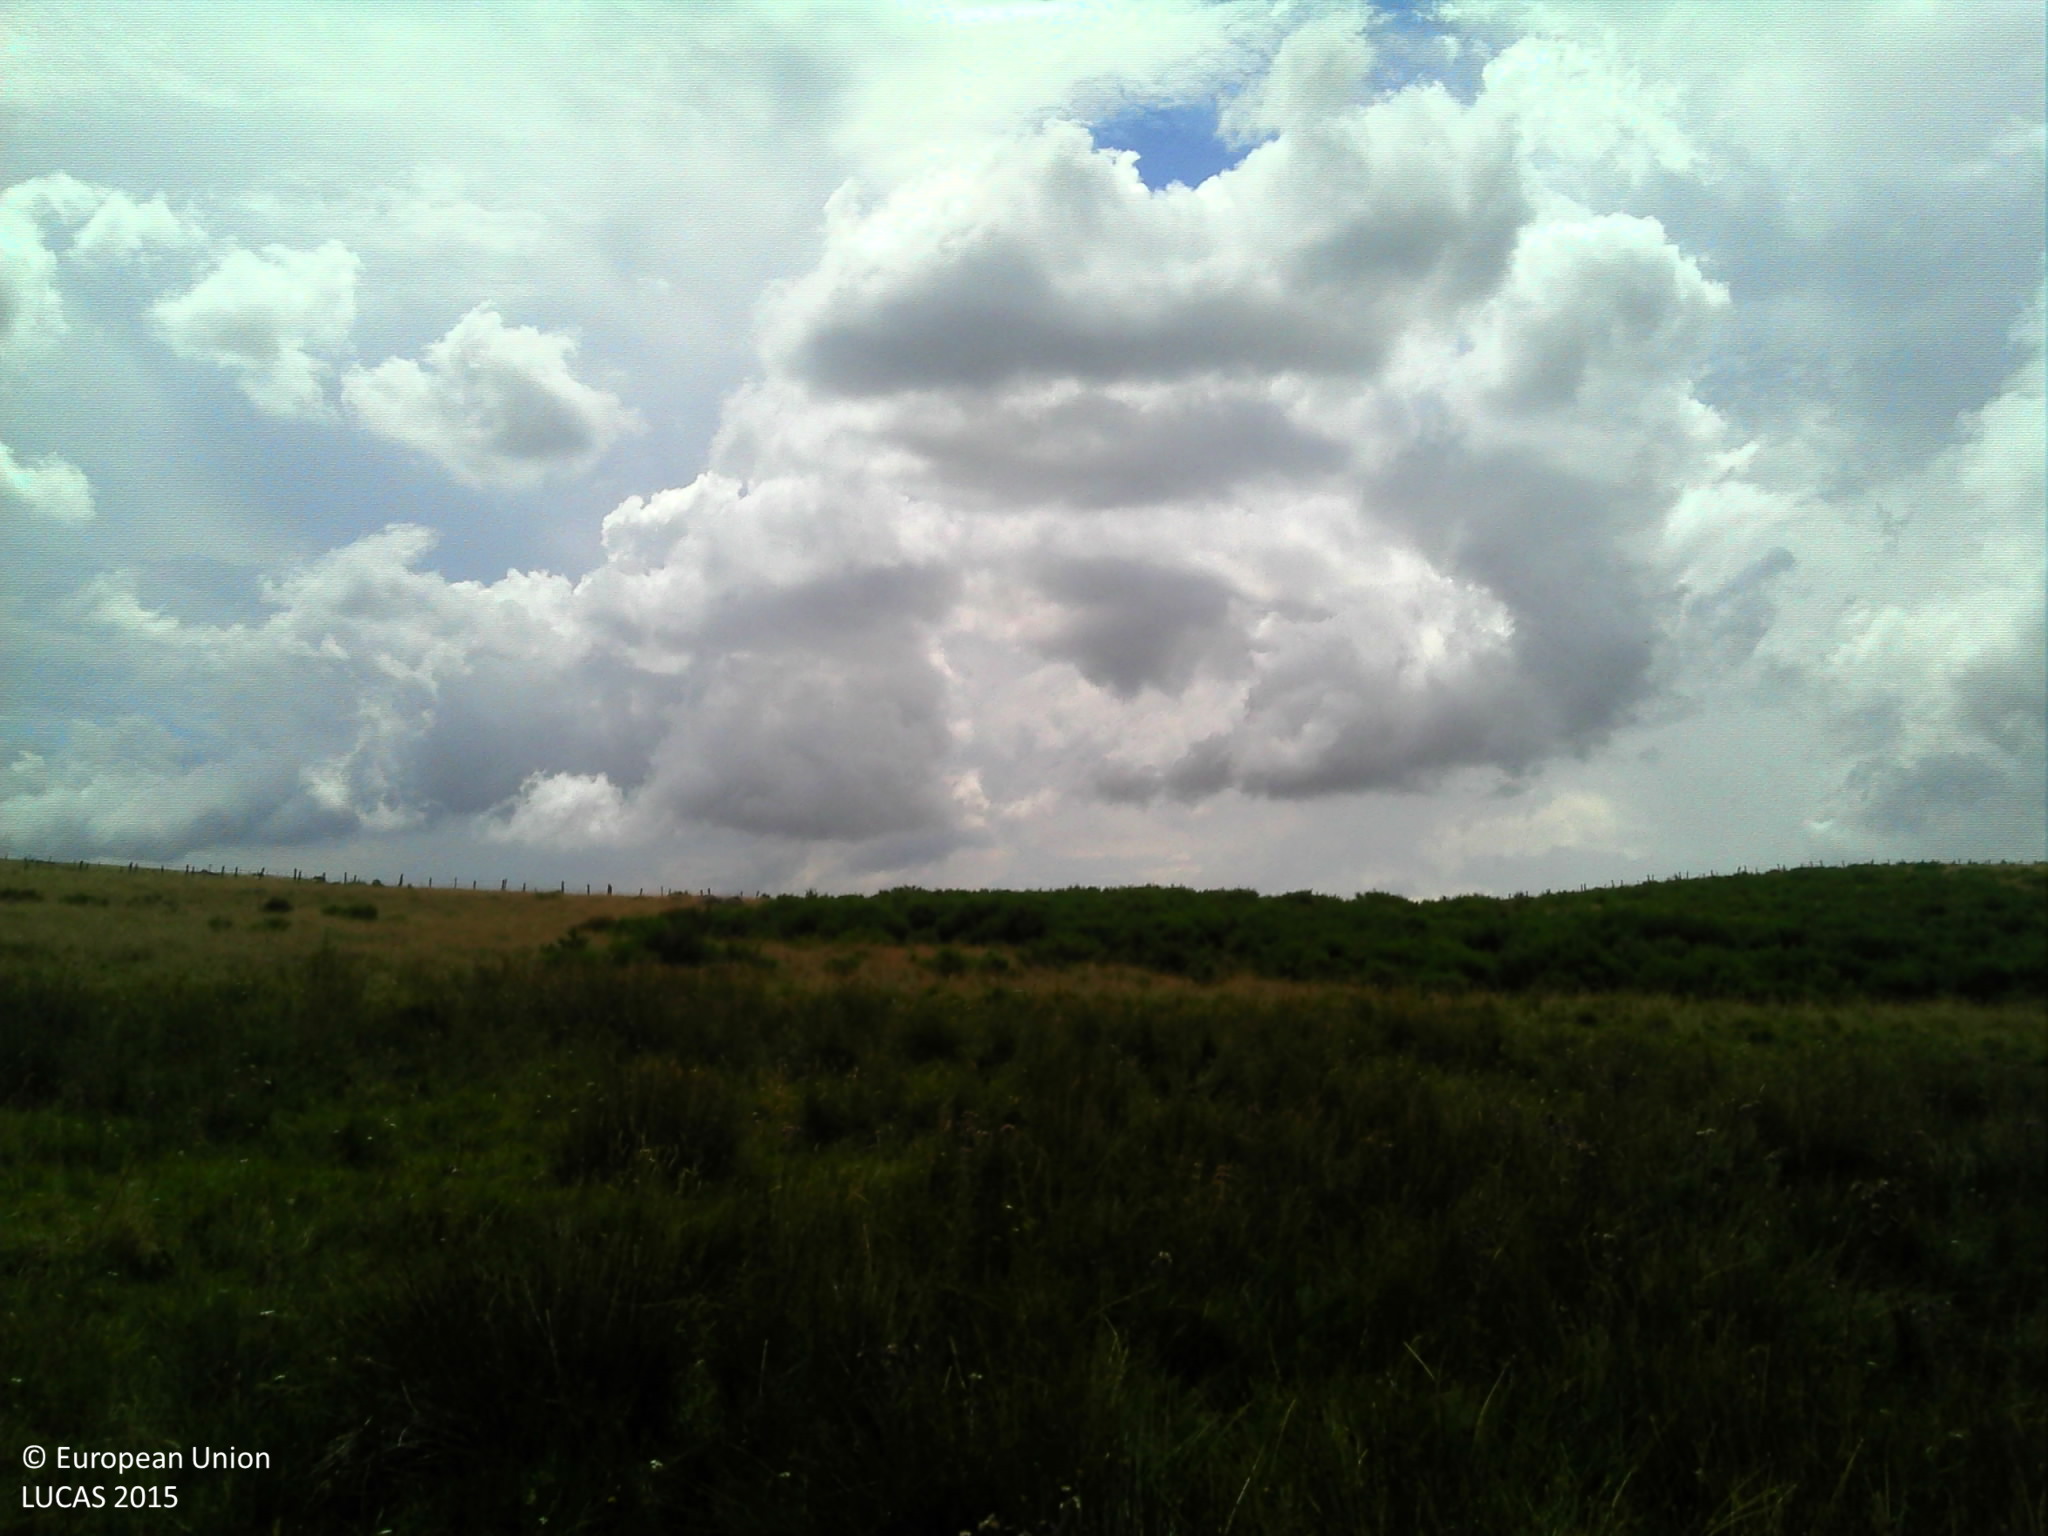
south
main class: Grassland
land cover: Grassland without tree/shrub cover
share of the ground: > 75 %
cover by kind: herbaceous plants 95 %, shrubs 5 %
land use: Agriculture (excluding fallow land and kitchen gardens)
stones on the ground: < 10 %
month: July
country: FR
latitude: 44.7161
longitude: 3.0730
